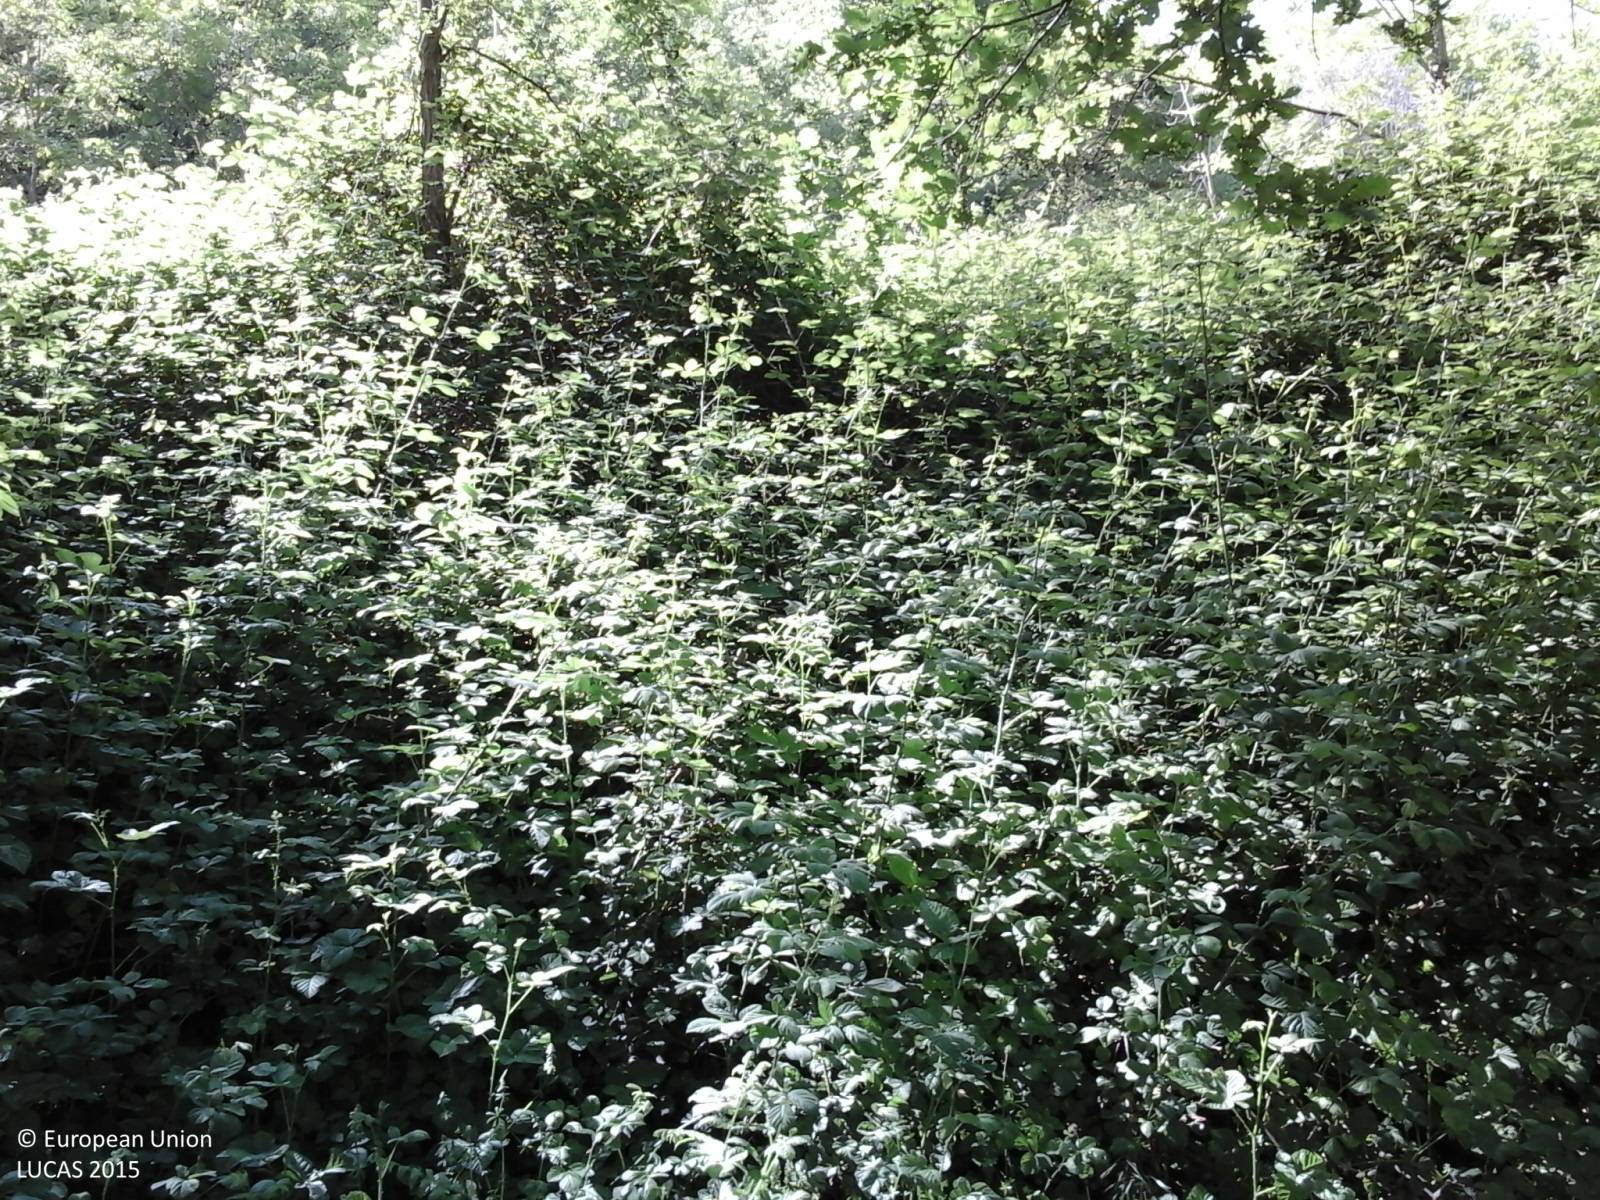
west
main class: Woodland
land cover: Broadleaved woodland
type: mesophytic deciduous forest
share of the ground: > 75 %
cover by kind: broadleaved forest trees 85 %, shrubs 15 %
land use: Forestry
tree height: > 5 m
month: May
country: IT
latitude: 46.2005
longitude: 13.0162
